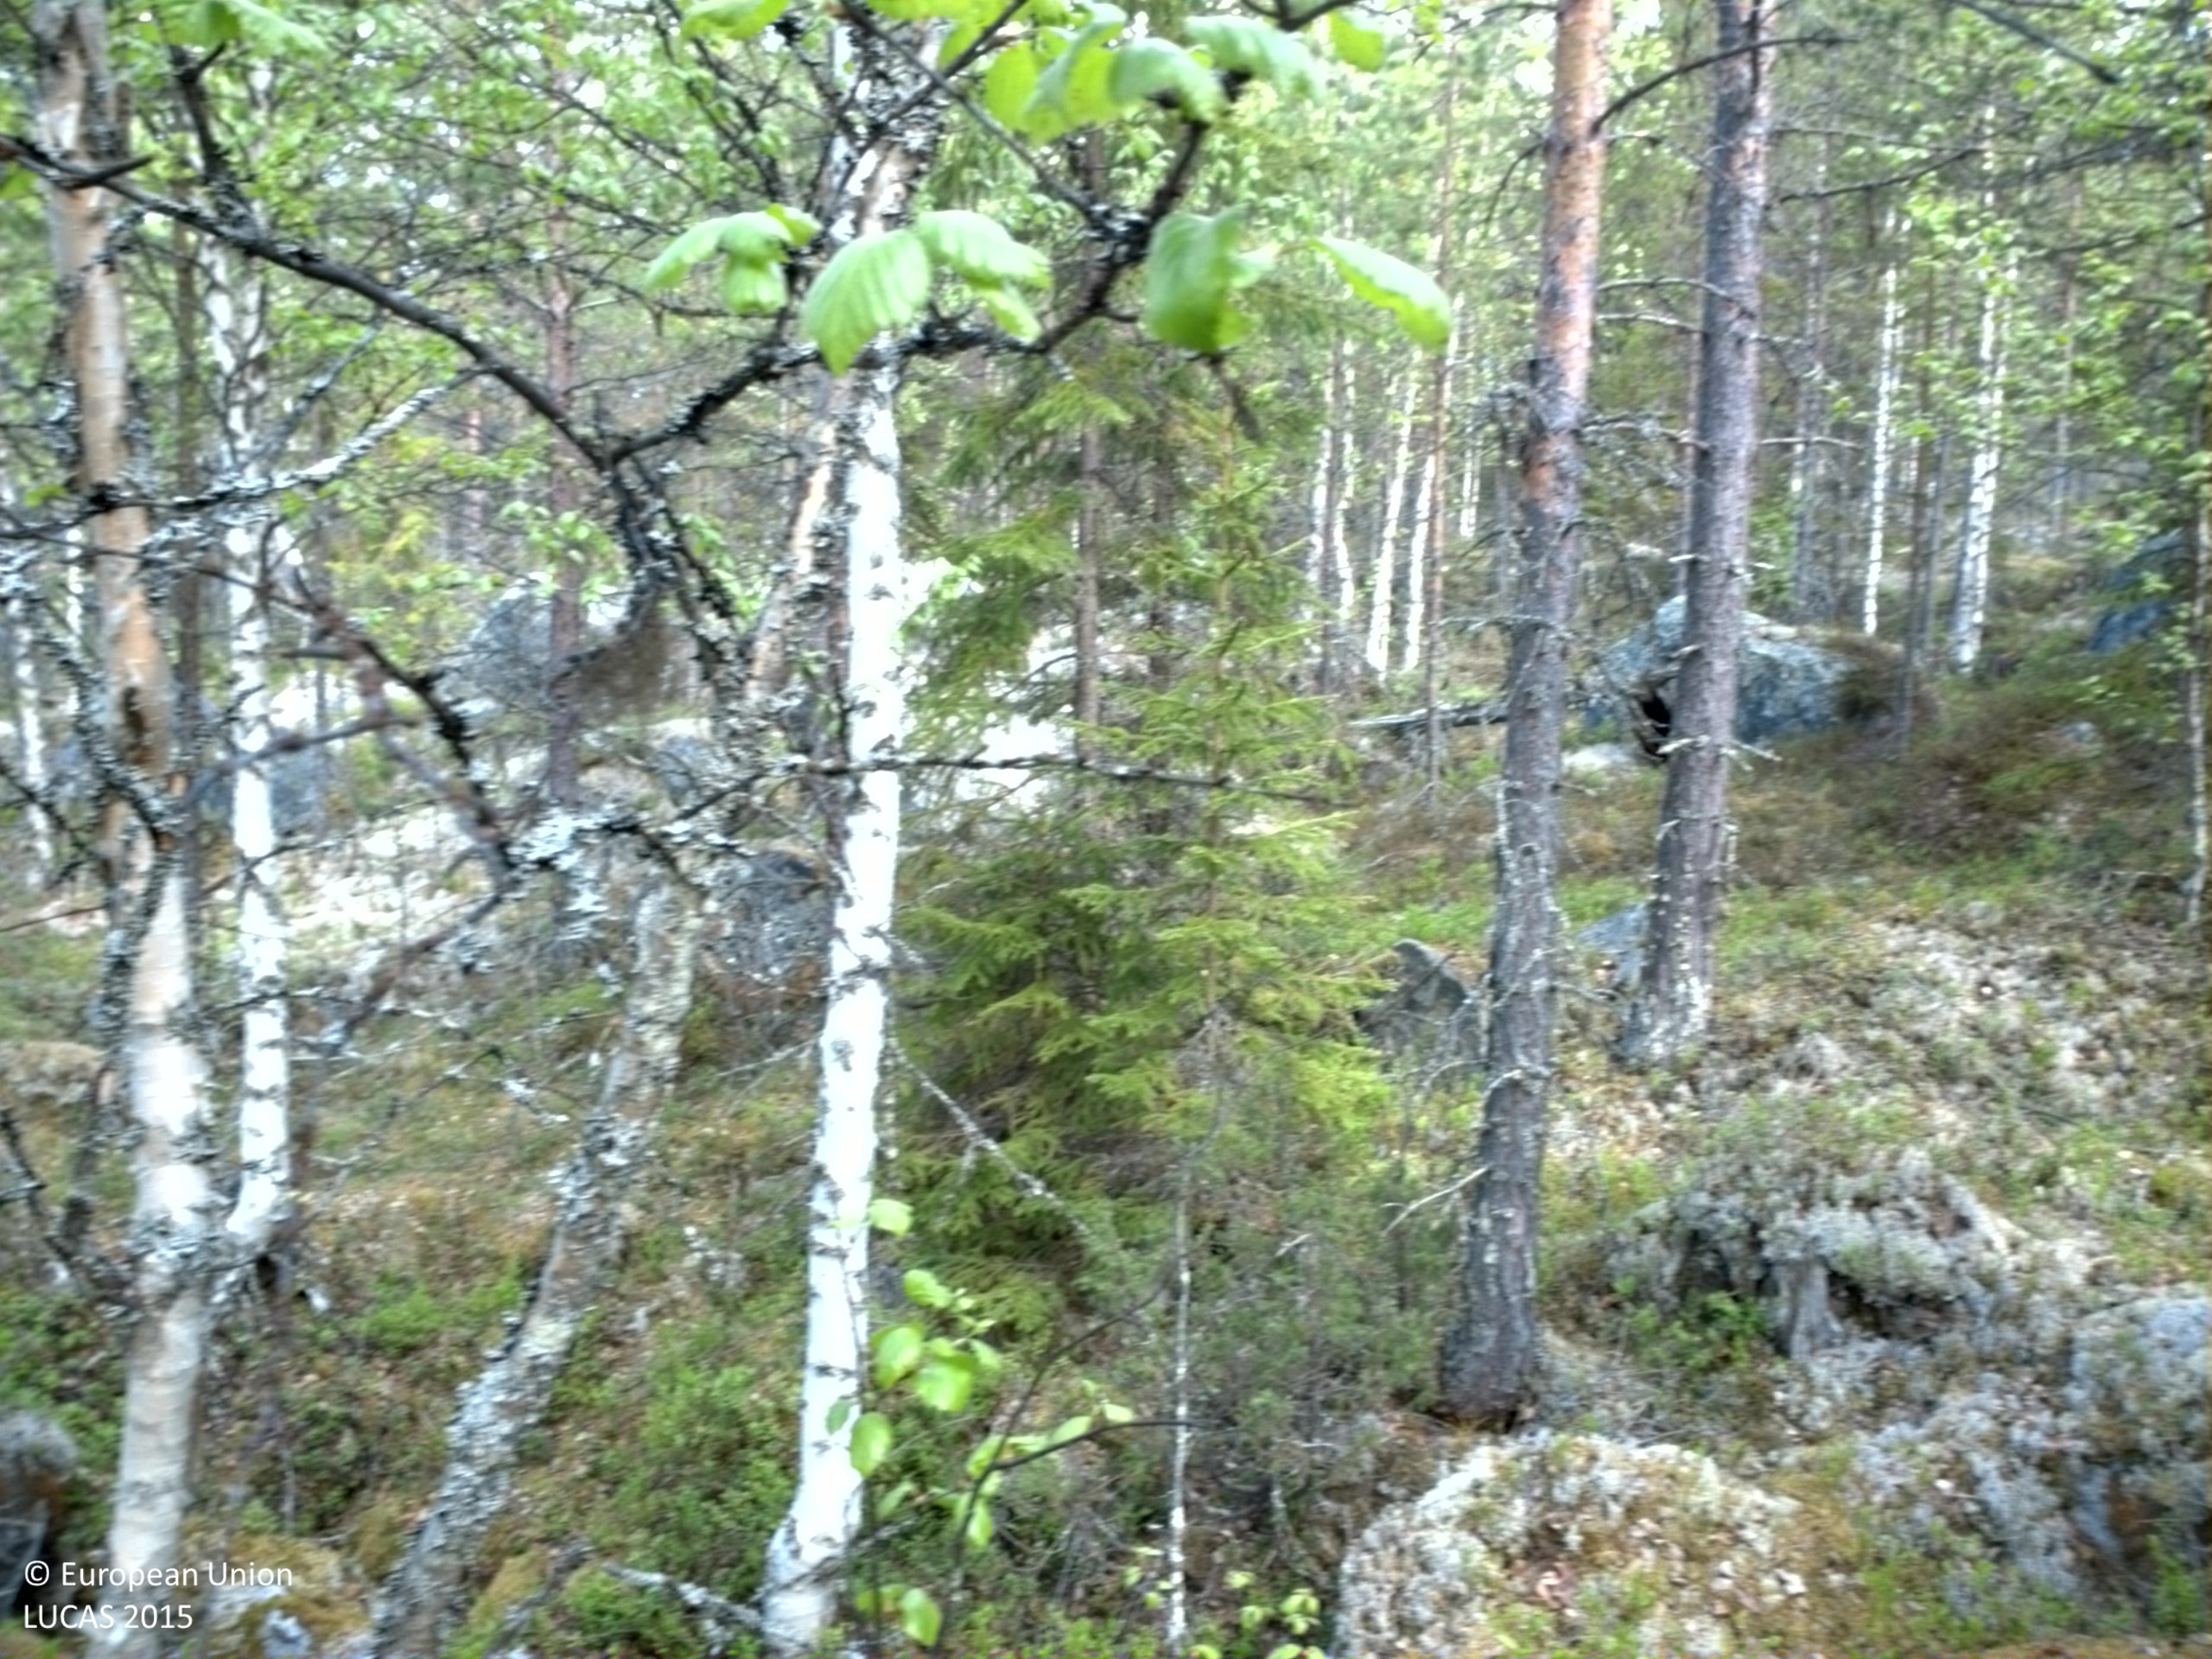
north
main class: Woodland
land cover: Pine dominated mixed woodland
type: boreal forest
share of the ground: 50 - 75 %
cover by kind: coniferous forest trees 50 %, shrubs 30 %, broadleaved forest trees 20 %
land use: Forestry
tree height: > 5 m
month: June
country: SE
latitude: 63.0204
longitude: 17.1881
